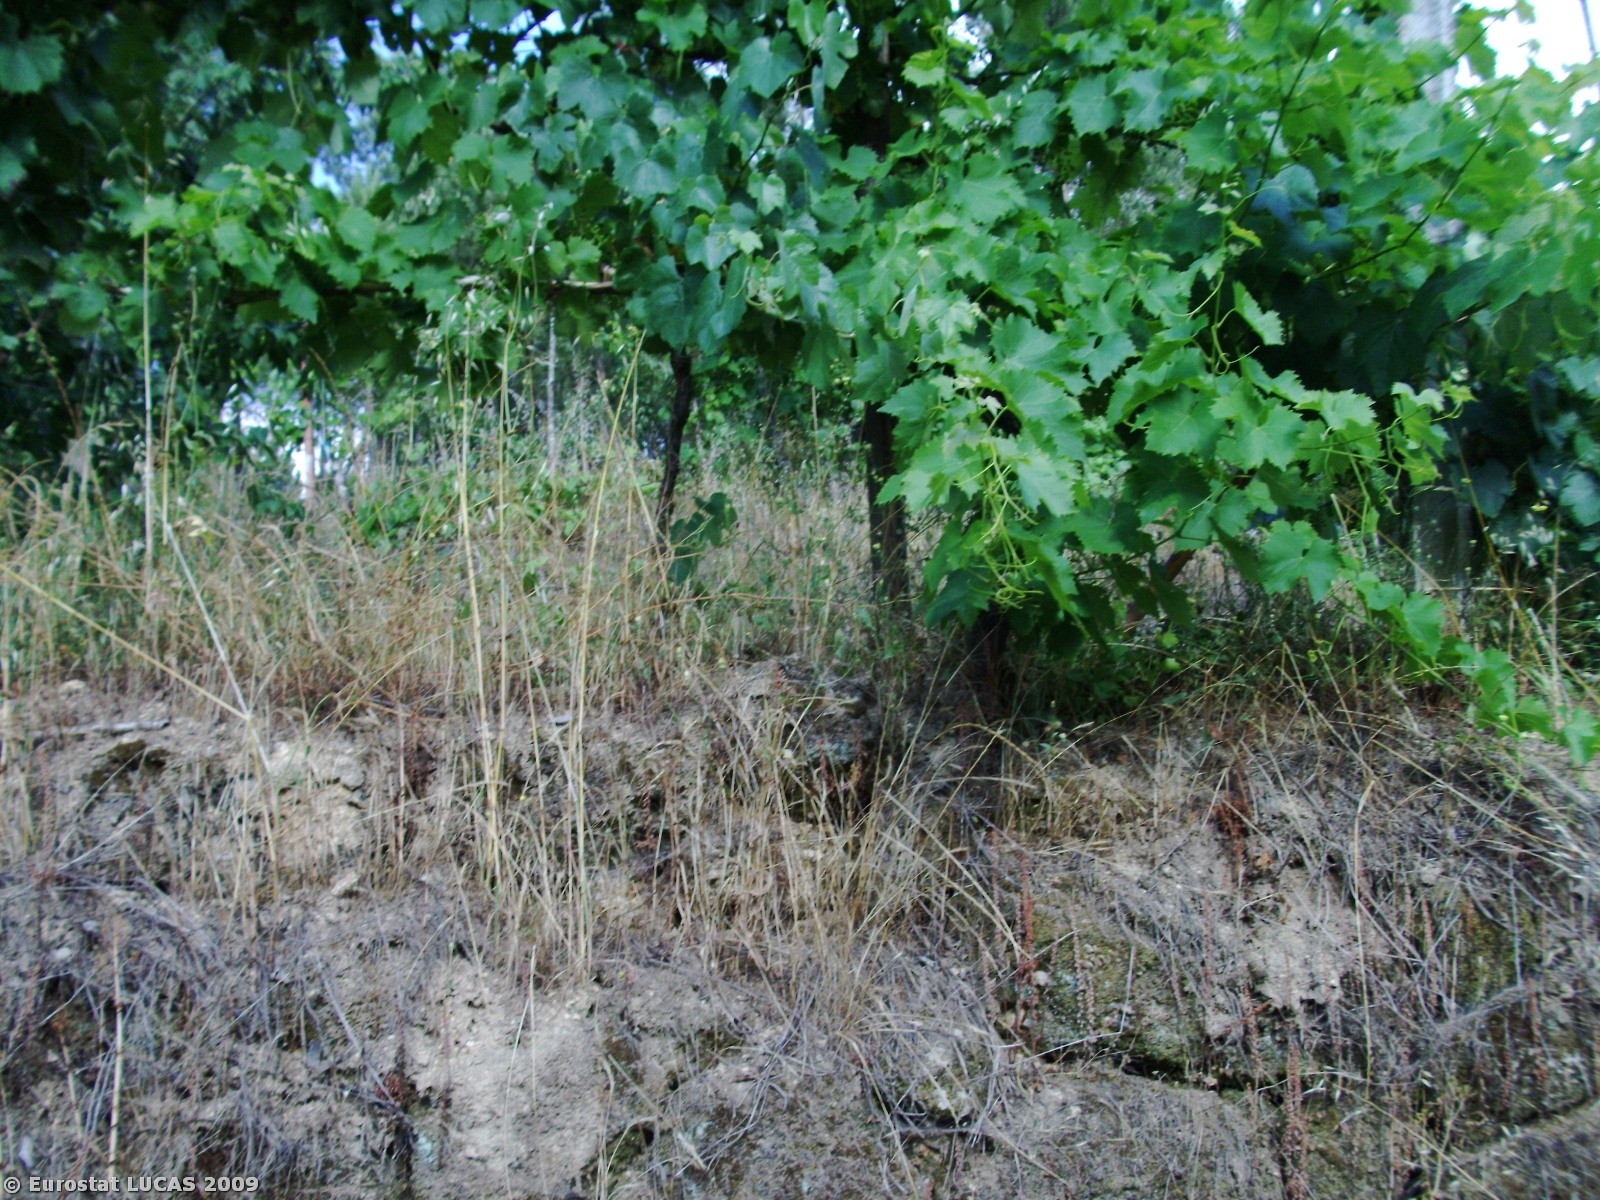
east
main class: Grassland
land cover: Spontaneously vegetated surfaces
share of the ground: 50 - 75 %
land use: Fallow land
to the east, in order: Spontaneously vegetated surfaces; Dry stone walls; Potatoes; Dry stone walls; Spontaneously vegetated surfaces; Tracks; Coniferous woodland; Tracks; Coniferous woodland; Tracks; Groves; Olive groves; Coniferous woodland; Olive groves; Abandoned hedges; Tracks; Abandoned hedges; Olive groves; Dry stone walls; Olive groves
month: June
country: PT
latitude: 40.3842
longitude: -7.7735
